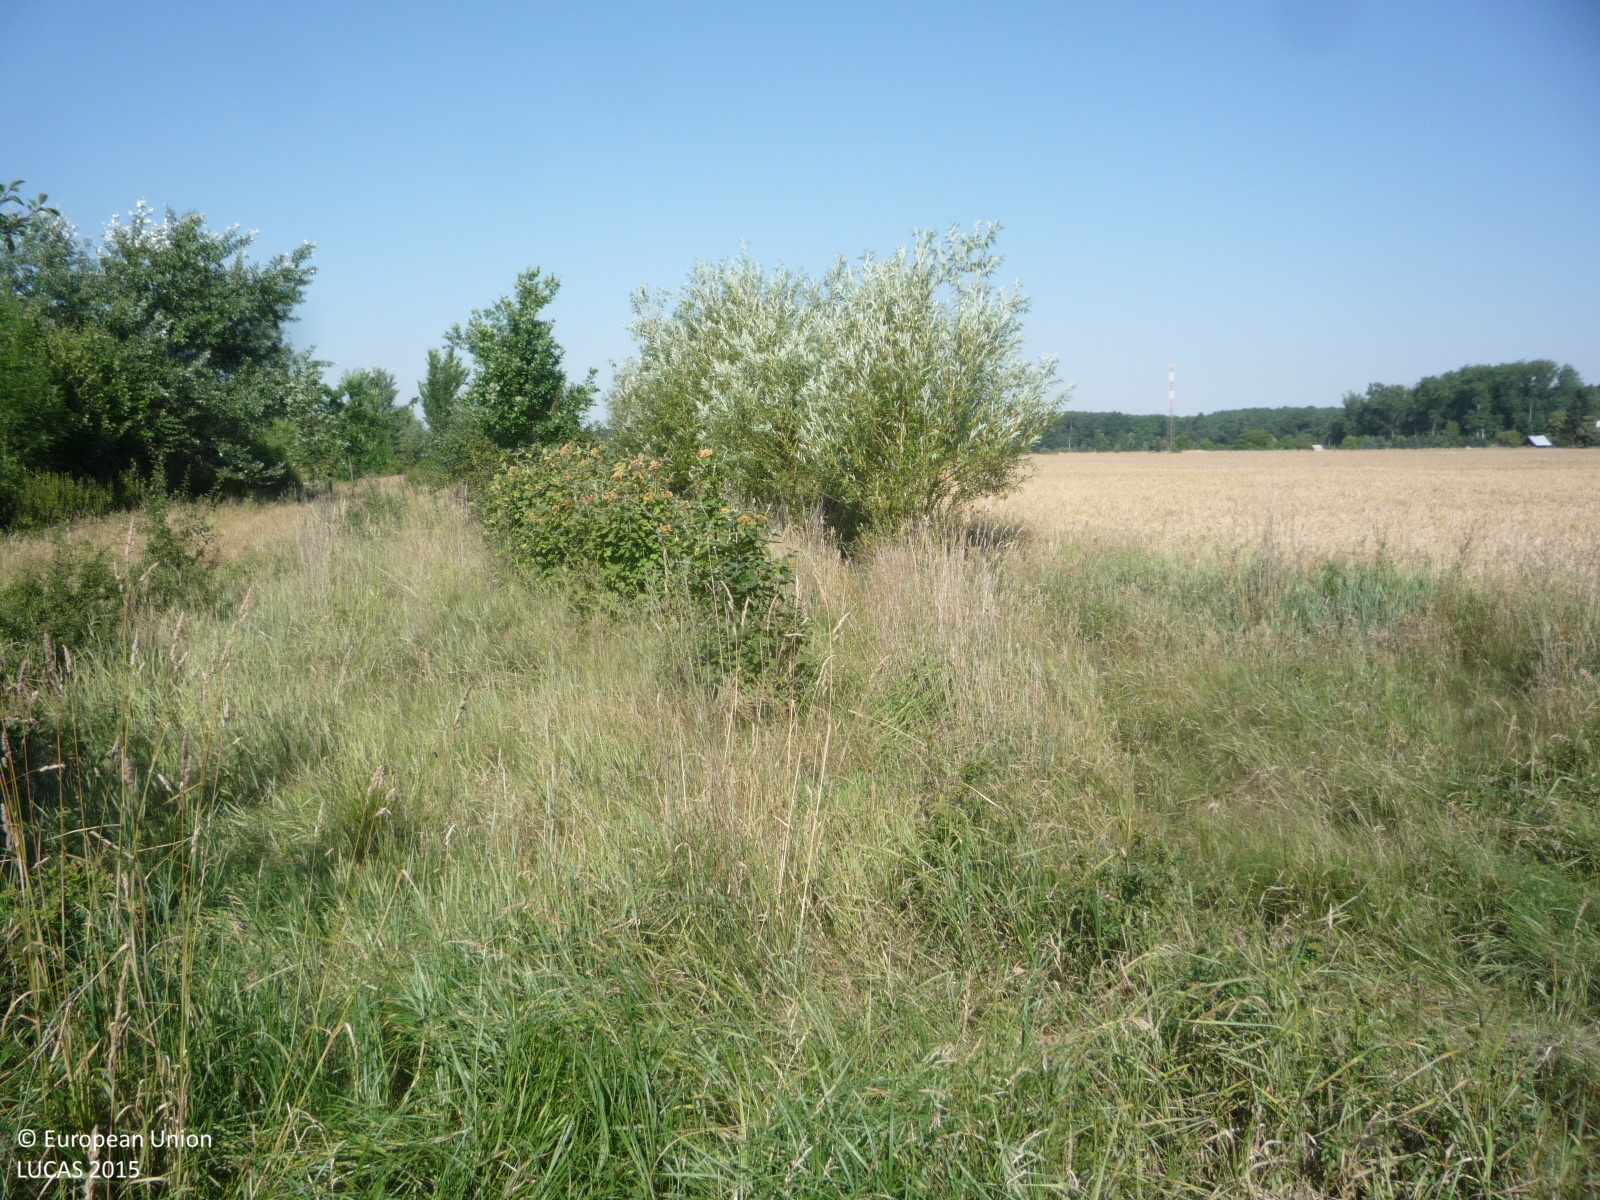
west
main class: Shrubland
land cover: Shrubland with sparse tree cover
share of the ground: > 75 %
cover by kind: shrubs 50 %, herbaceous plants 45 %, broadleaved forest trees 5 %
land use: Agriculture (excluding fallow land and kitchen gardens)
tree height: < 5 m
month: July
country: CZ
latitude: 50.1175
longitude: 15.2479
